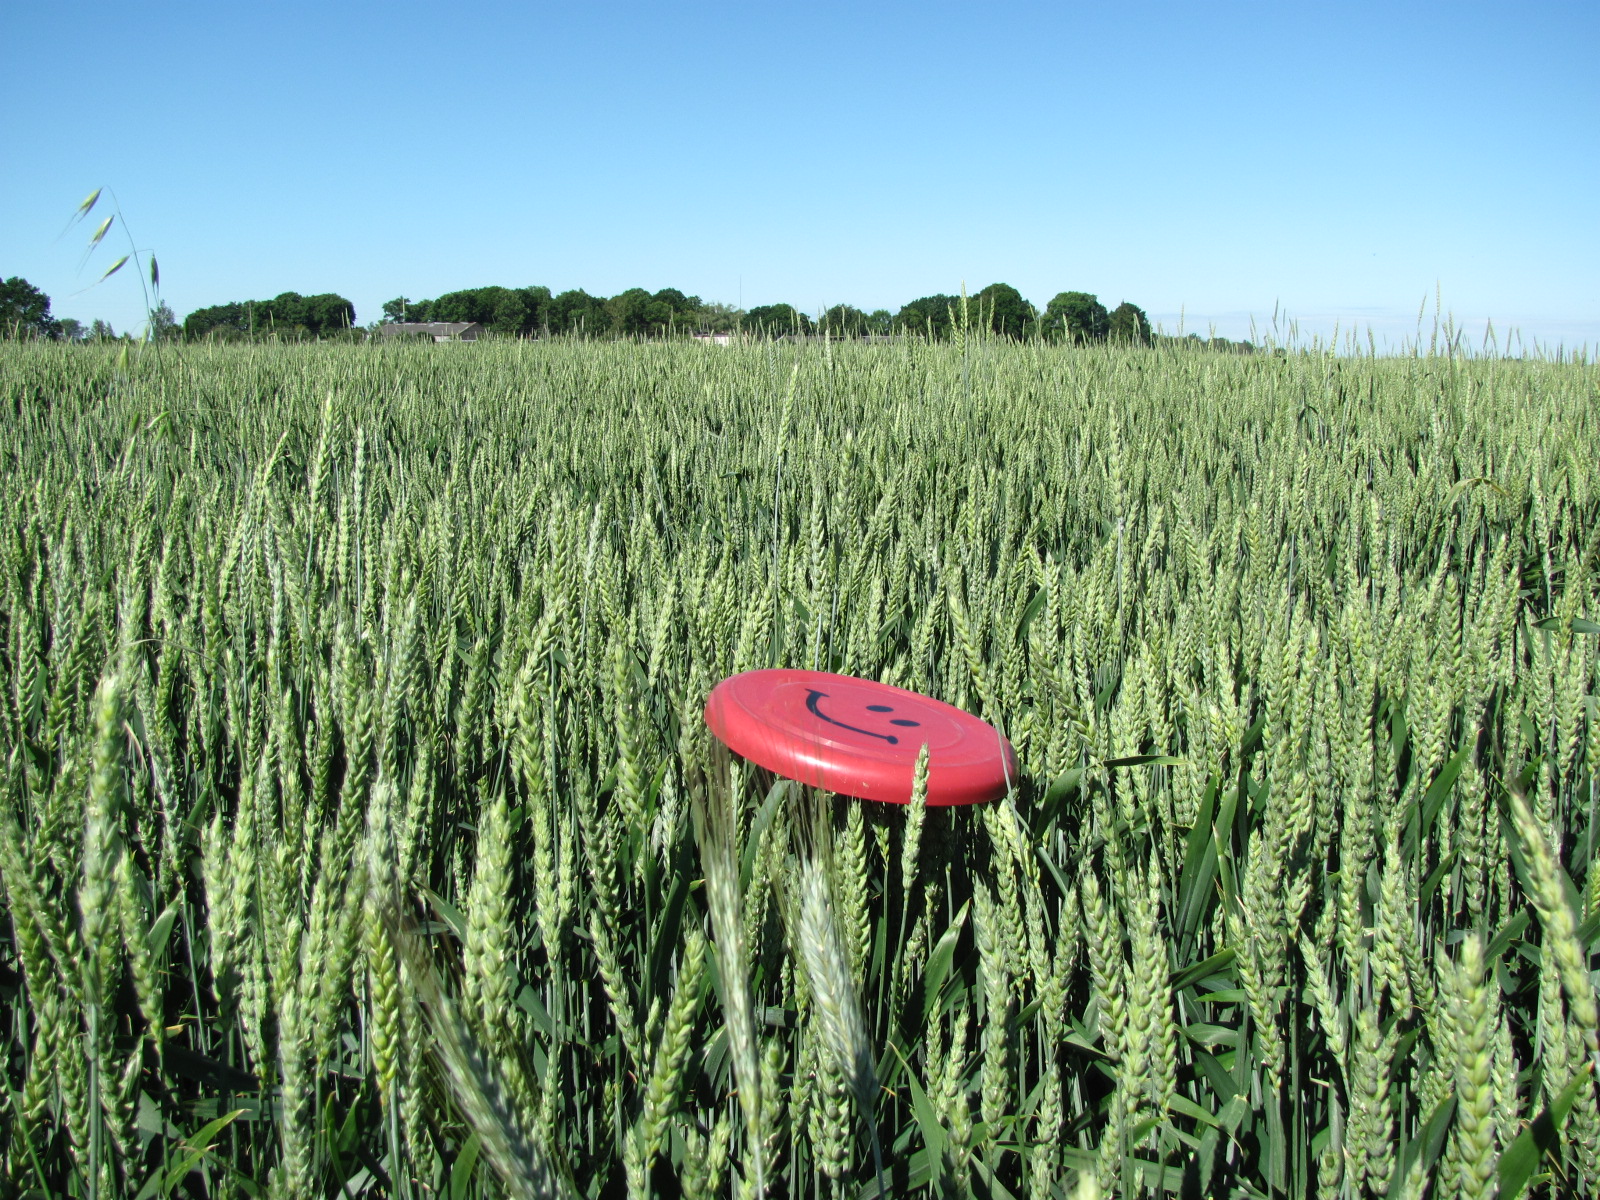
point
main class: Cropland
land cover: Common wheat
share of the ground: > 75 %
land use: Agriculture (excluding fallow land and kitchen gardens)
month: July
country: LV
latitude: 56.4964
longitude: 23.8072
